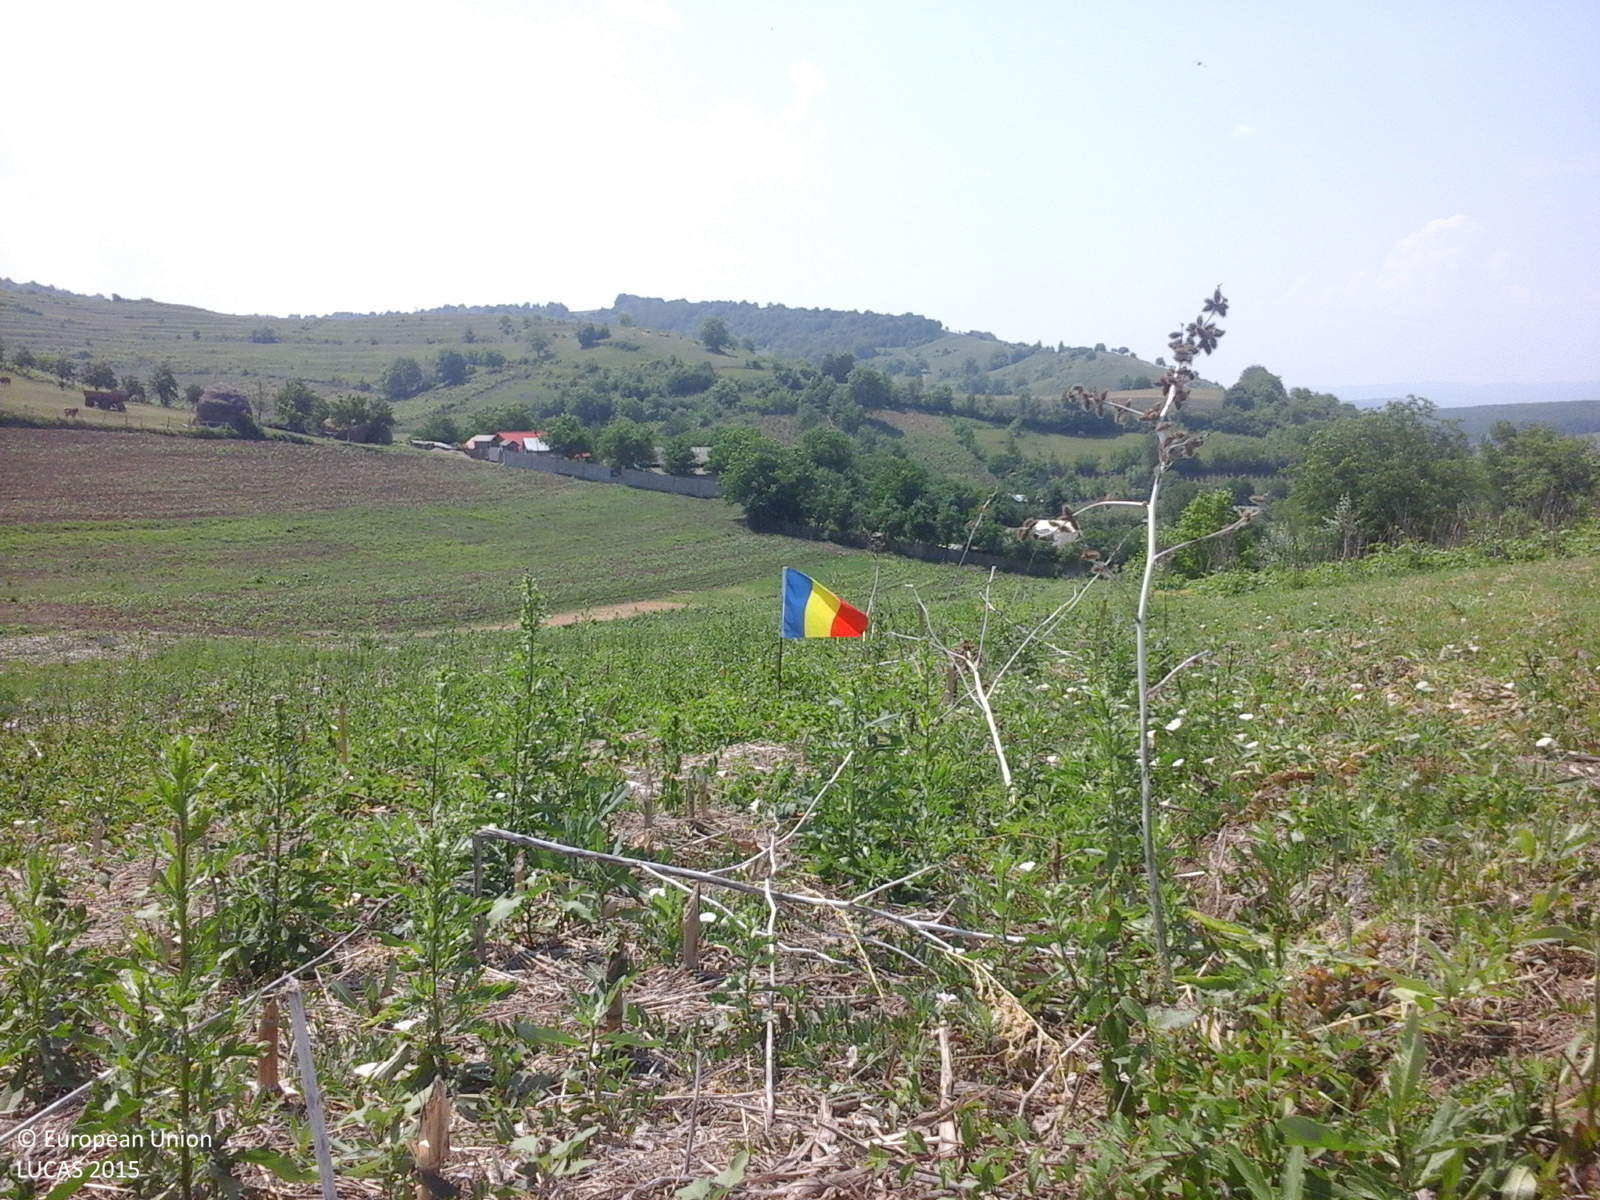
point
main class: Grassland
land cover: Spontaneously vegetated surfaces
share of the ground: > 75 %
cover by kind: herbaceous plants 100 %
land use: Agriculture (excluding fallow land and kitchen gardens)
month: June
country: RO
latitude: 46.3923
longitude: 27.1217
